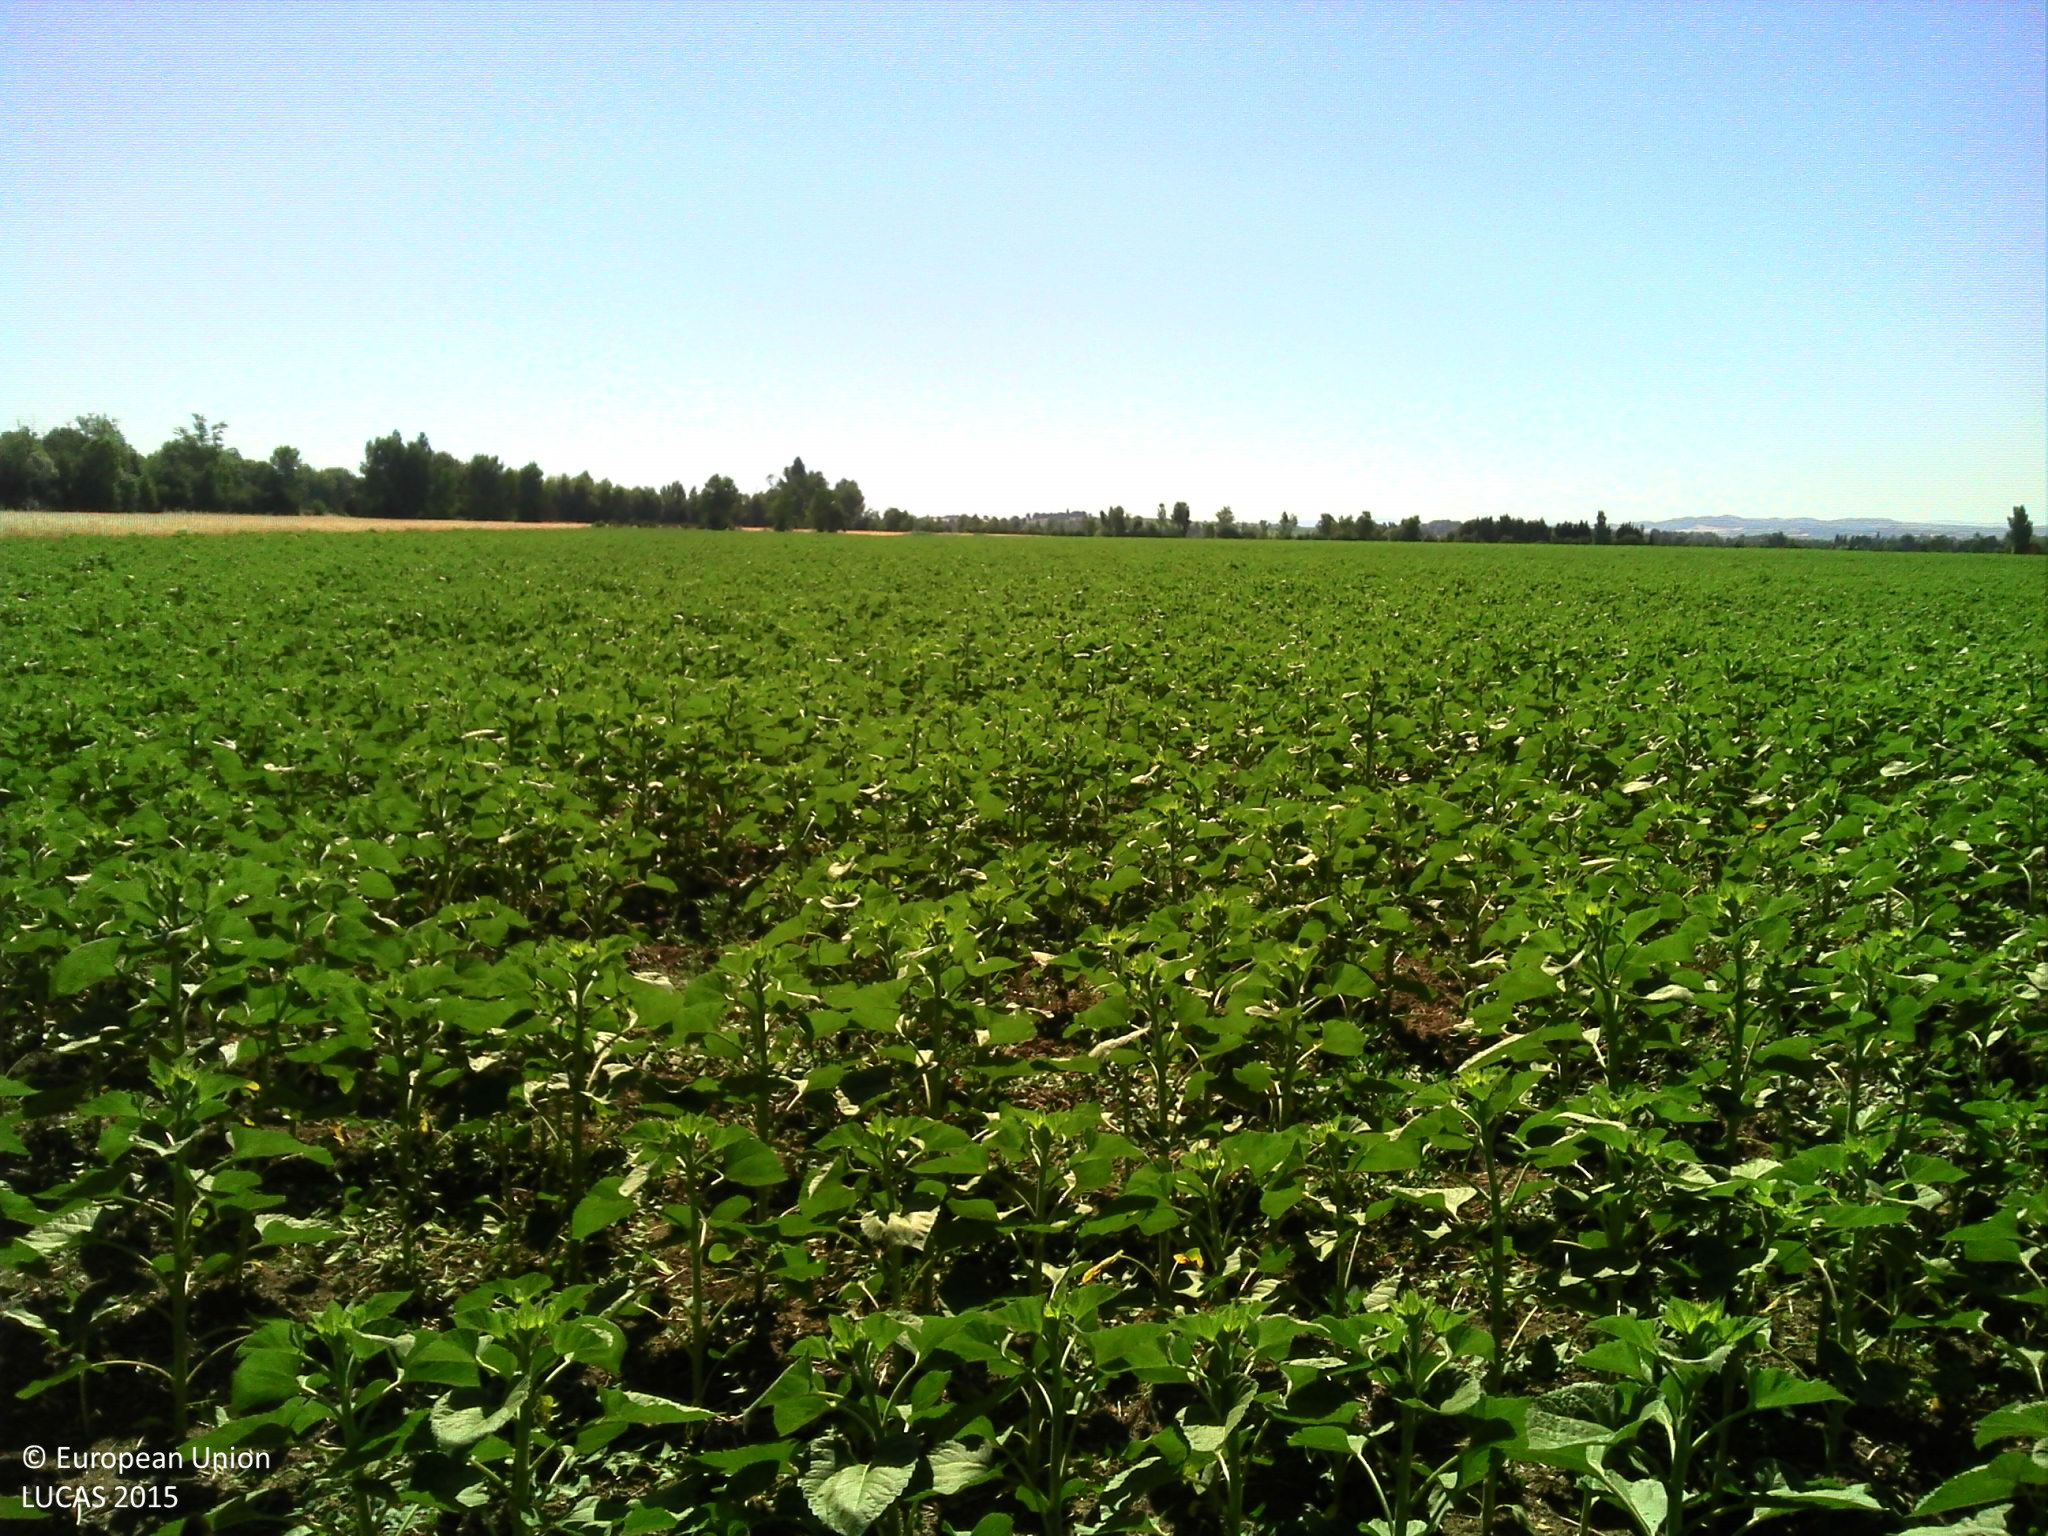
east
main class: Cropland
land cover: Sunflower
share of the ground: 50 - 75 %
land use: Agriculture (excluding fallow land and kitchen gardens)
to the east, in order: Sunflower; Barley
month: June
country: FR
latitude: 43.2828
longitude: 2.0335
